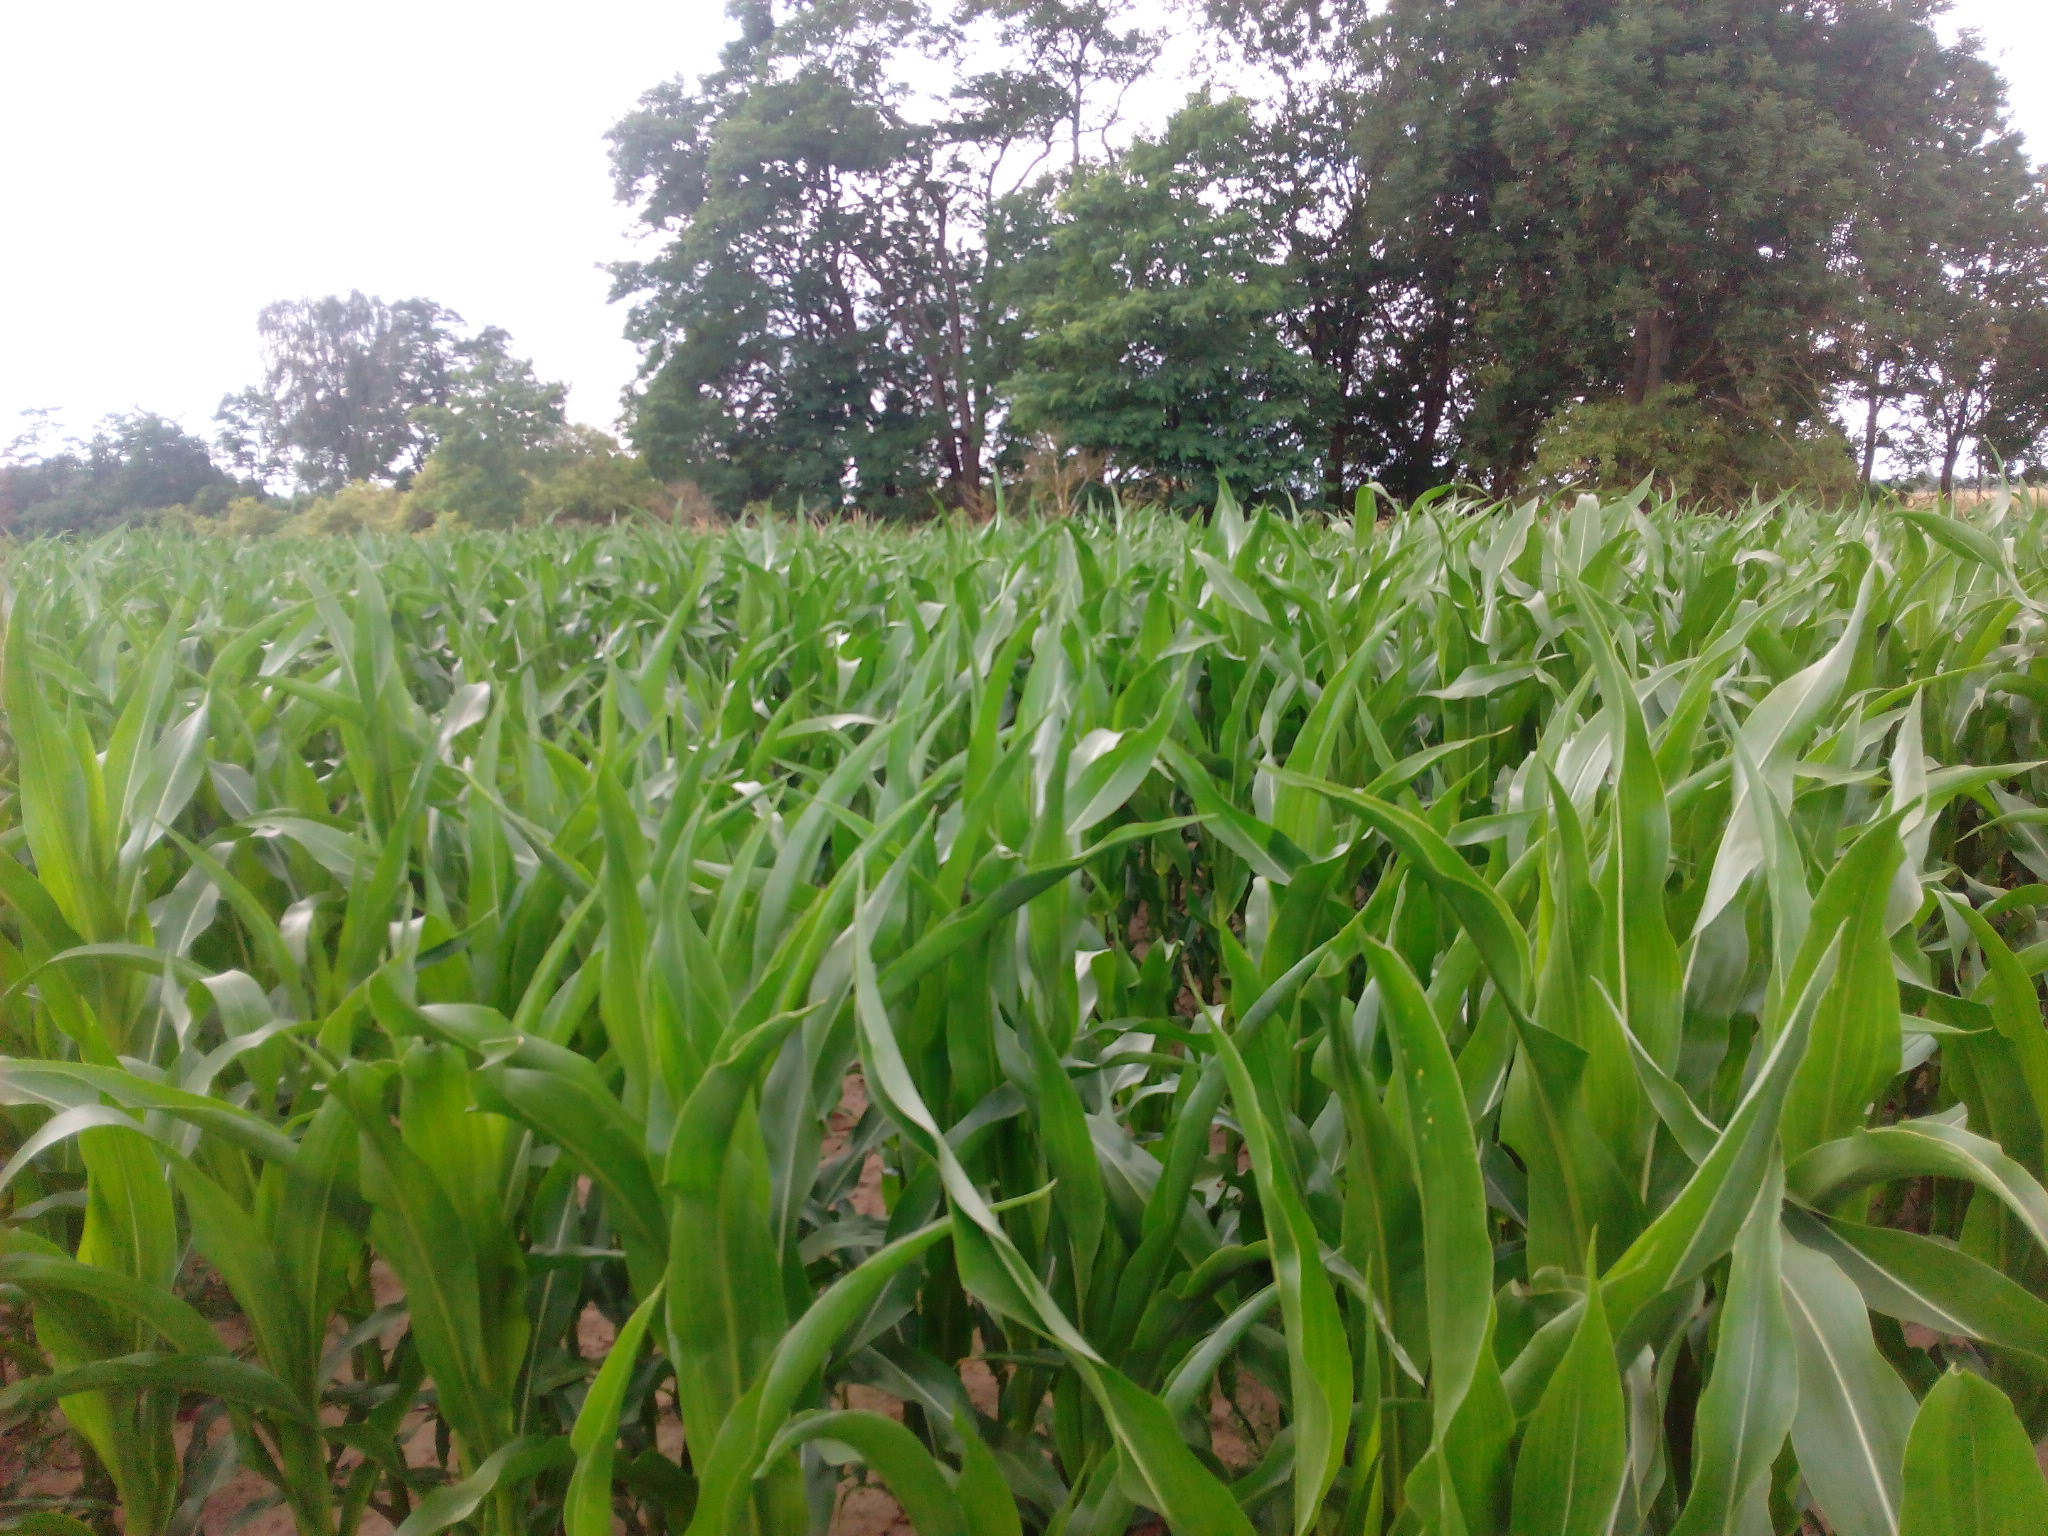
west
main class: Cropland
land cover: Maize
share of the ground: 50 - 75 %
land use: Agriculture (excluding fallow land and kitchen gardens)
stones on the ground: < 10 %
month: July
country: DE
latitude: 53.3981
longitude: 14.2870
